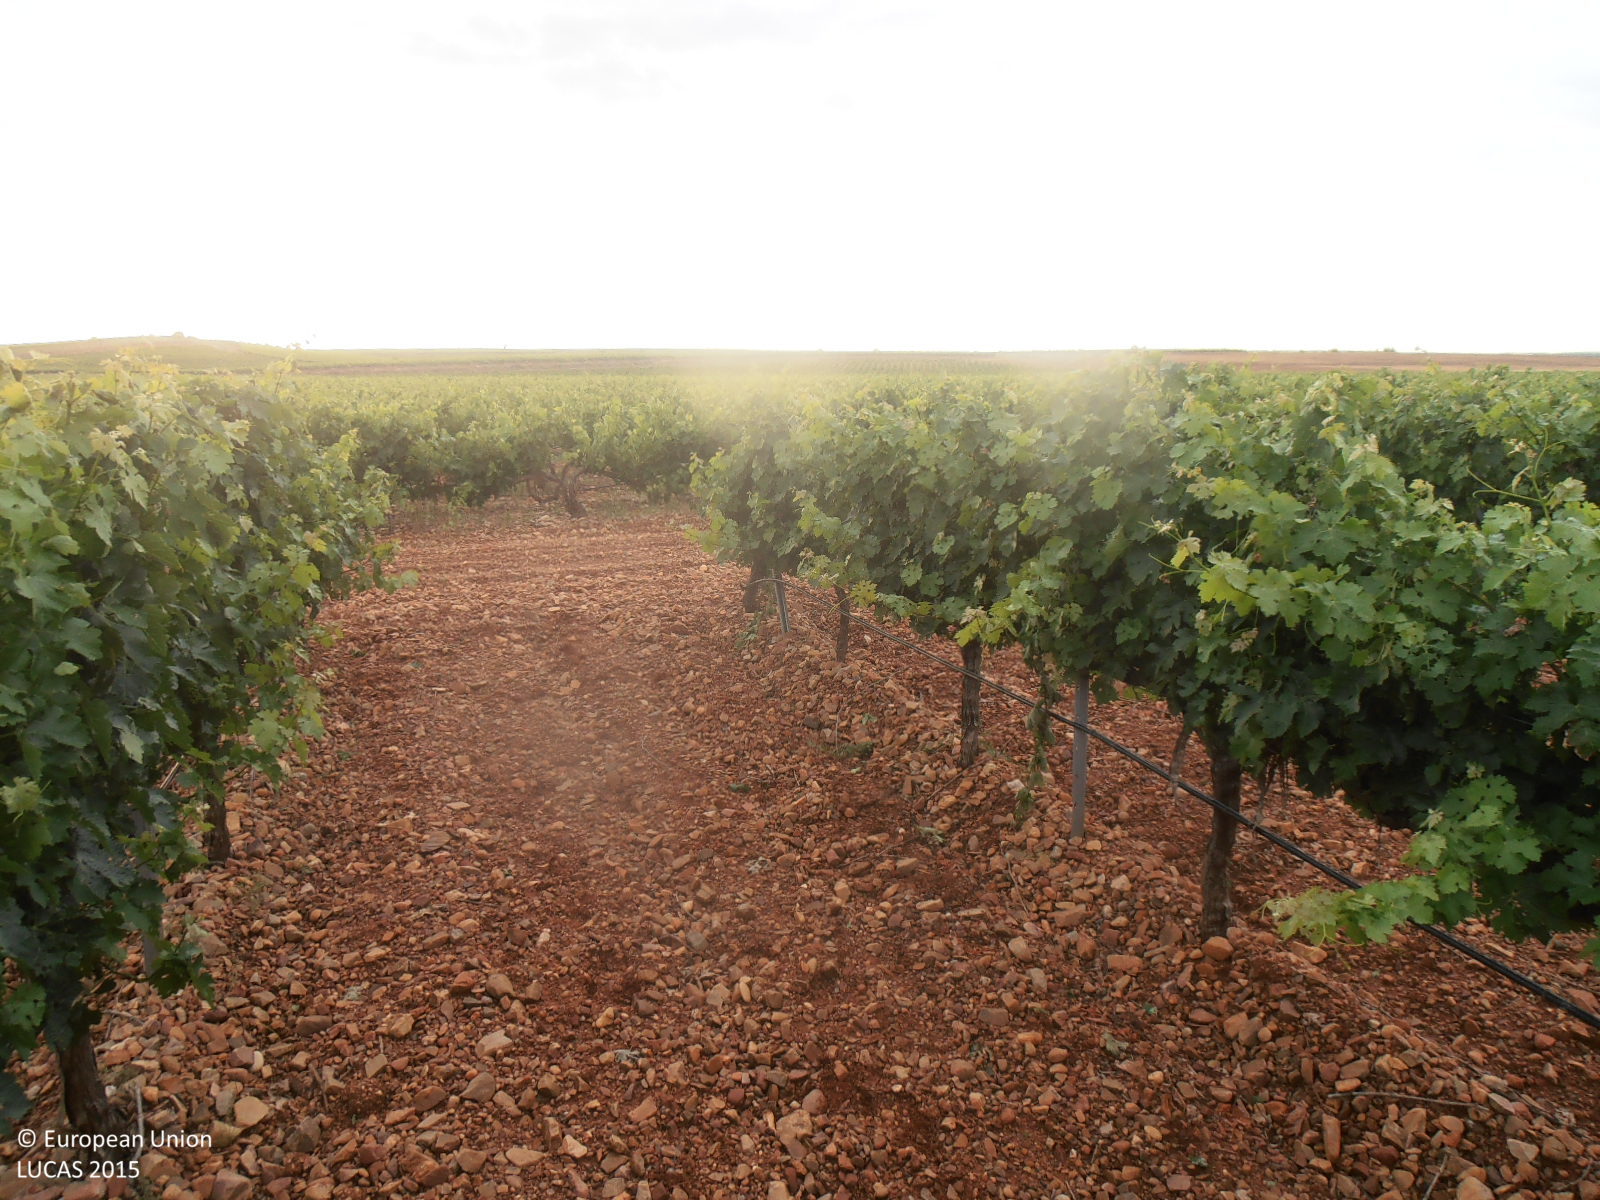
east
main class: Cropland
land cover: Vineyards
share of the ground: 25 - 50 %
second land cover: Other bare soil
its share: > 75 %
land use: Agriculture (excluding fallow land and kitchen gardens)
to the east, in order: Vineyards; Other bare soil; Tracks; Vineyards; Tracks; Grass margins; Vineyards
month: June
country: ES
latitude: 41.3926
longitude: -1.2042
